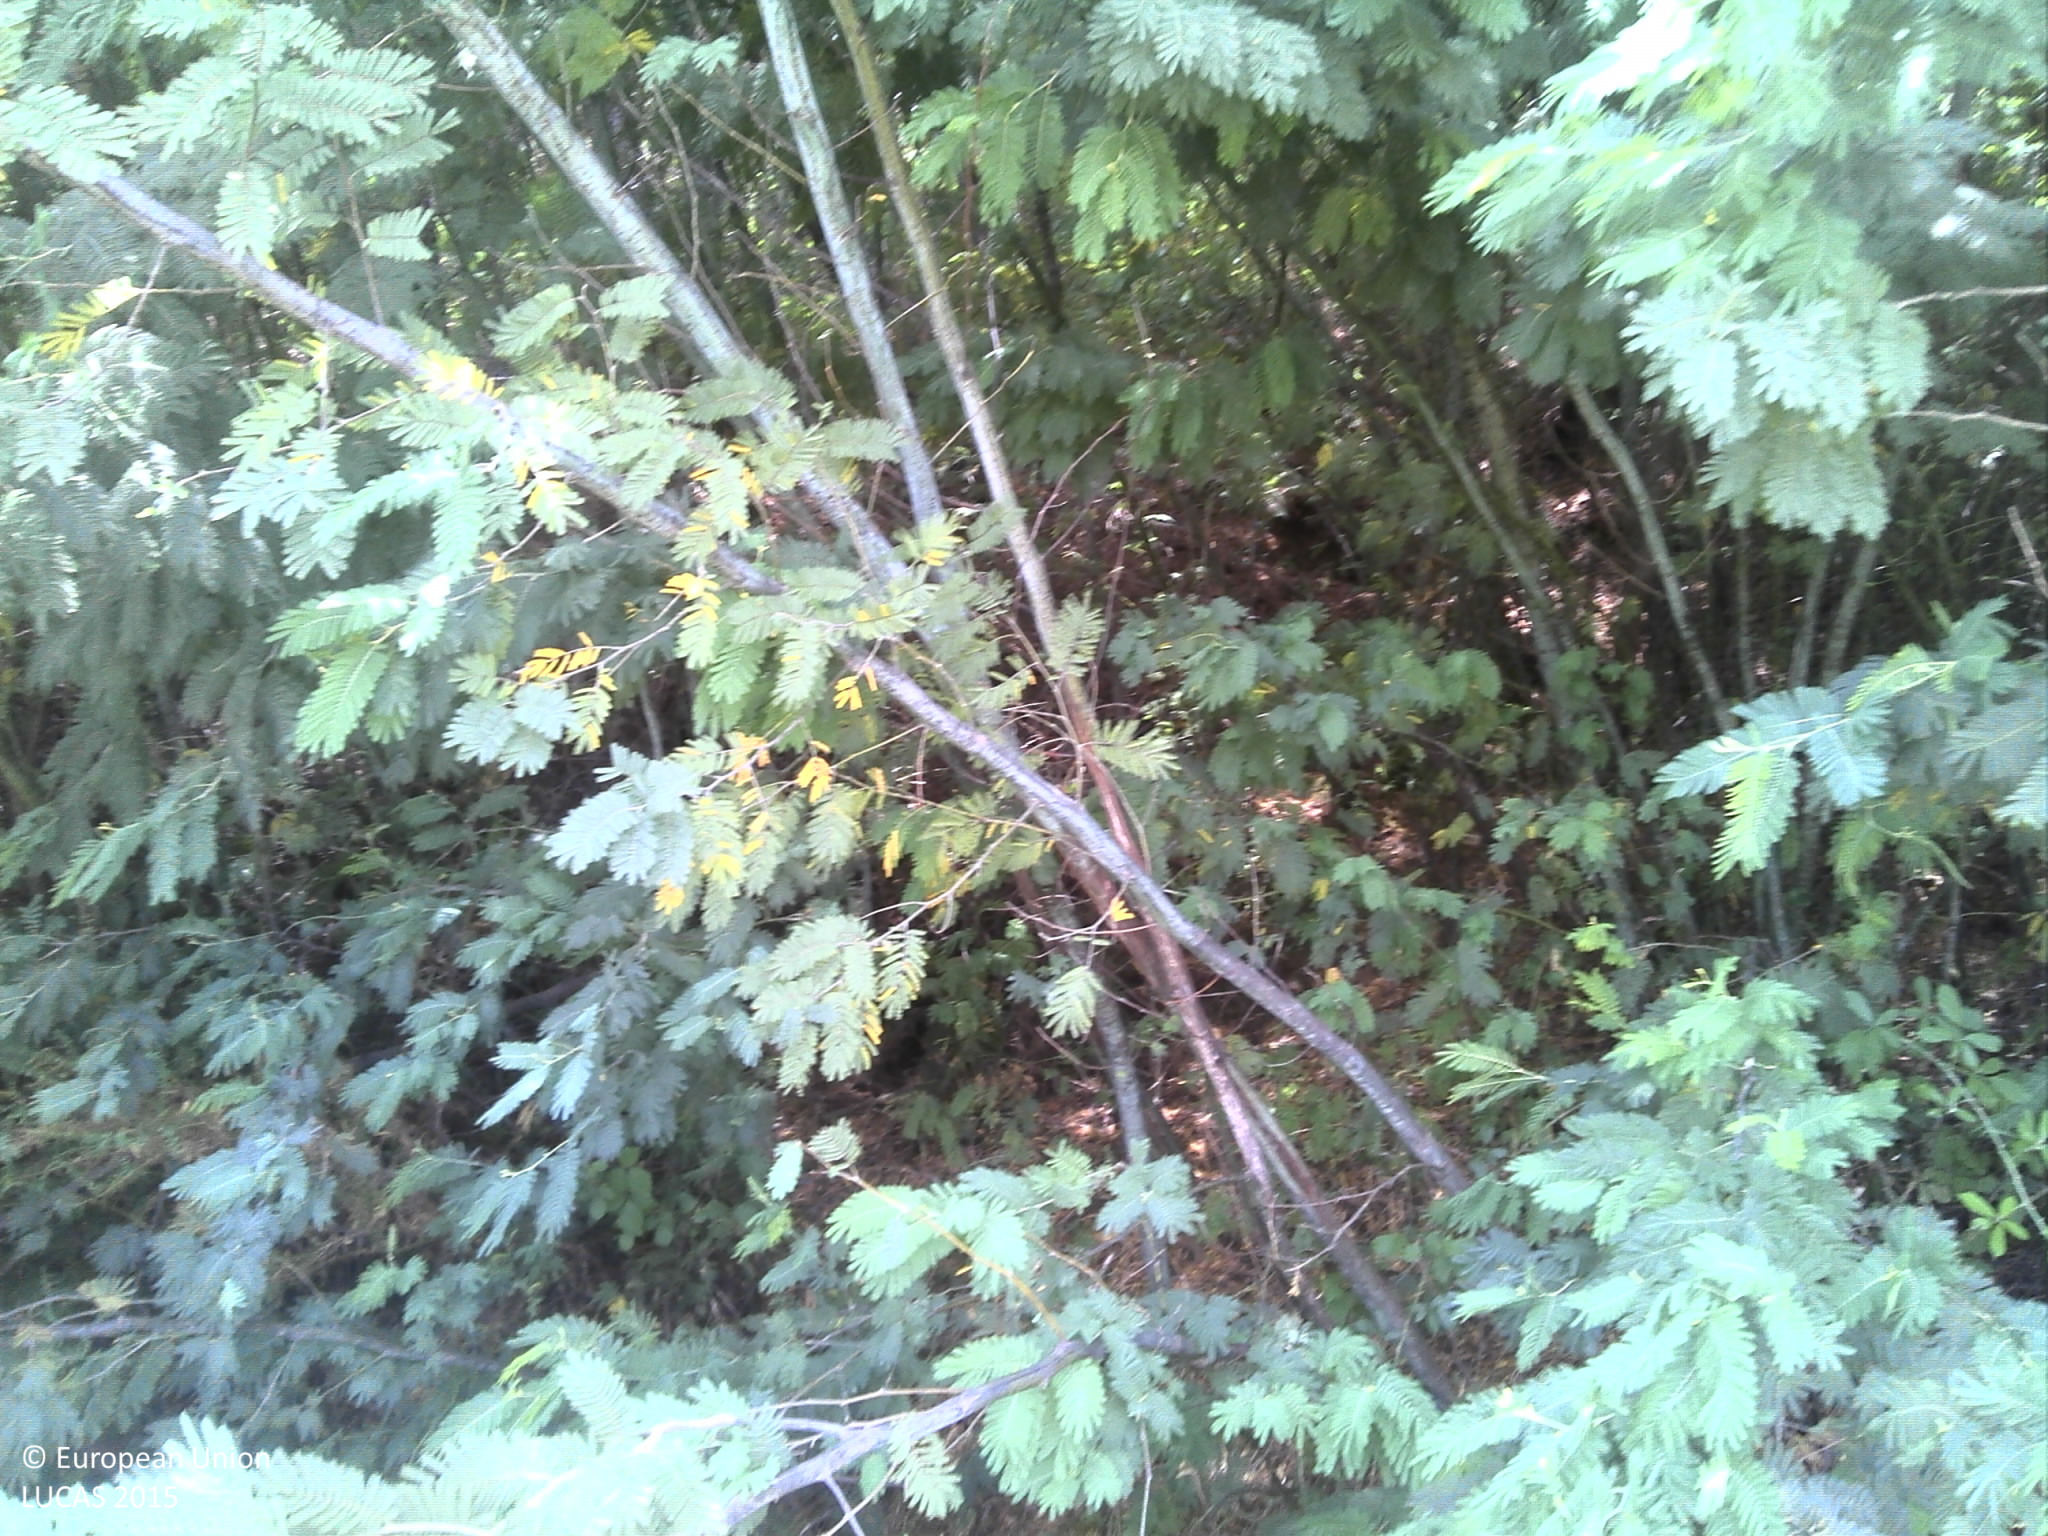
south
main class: Woodland
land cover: Broadleaved woodland
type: exotic forest
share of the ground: > 75 %
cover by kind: broadleaved forest trees 85 %, unconsolidated bare surface 10 %, shrubs 5 %
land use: Forestry
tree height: > 5 m
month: June
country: PT
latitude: 40.1482
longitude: -7.3453
